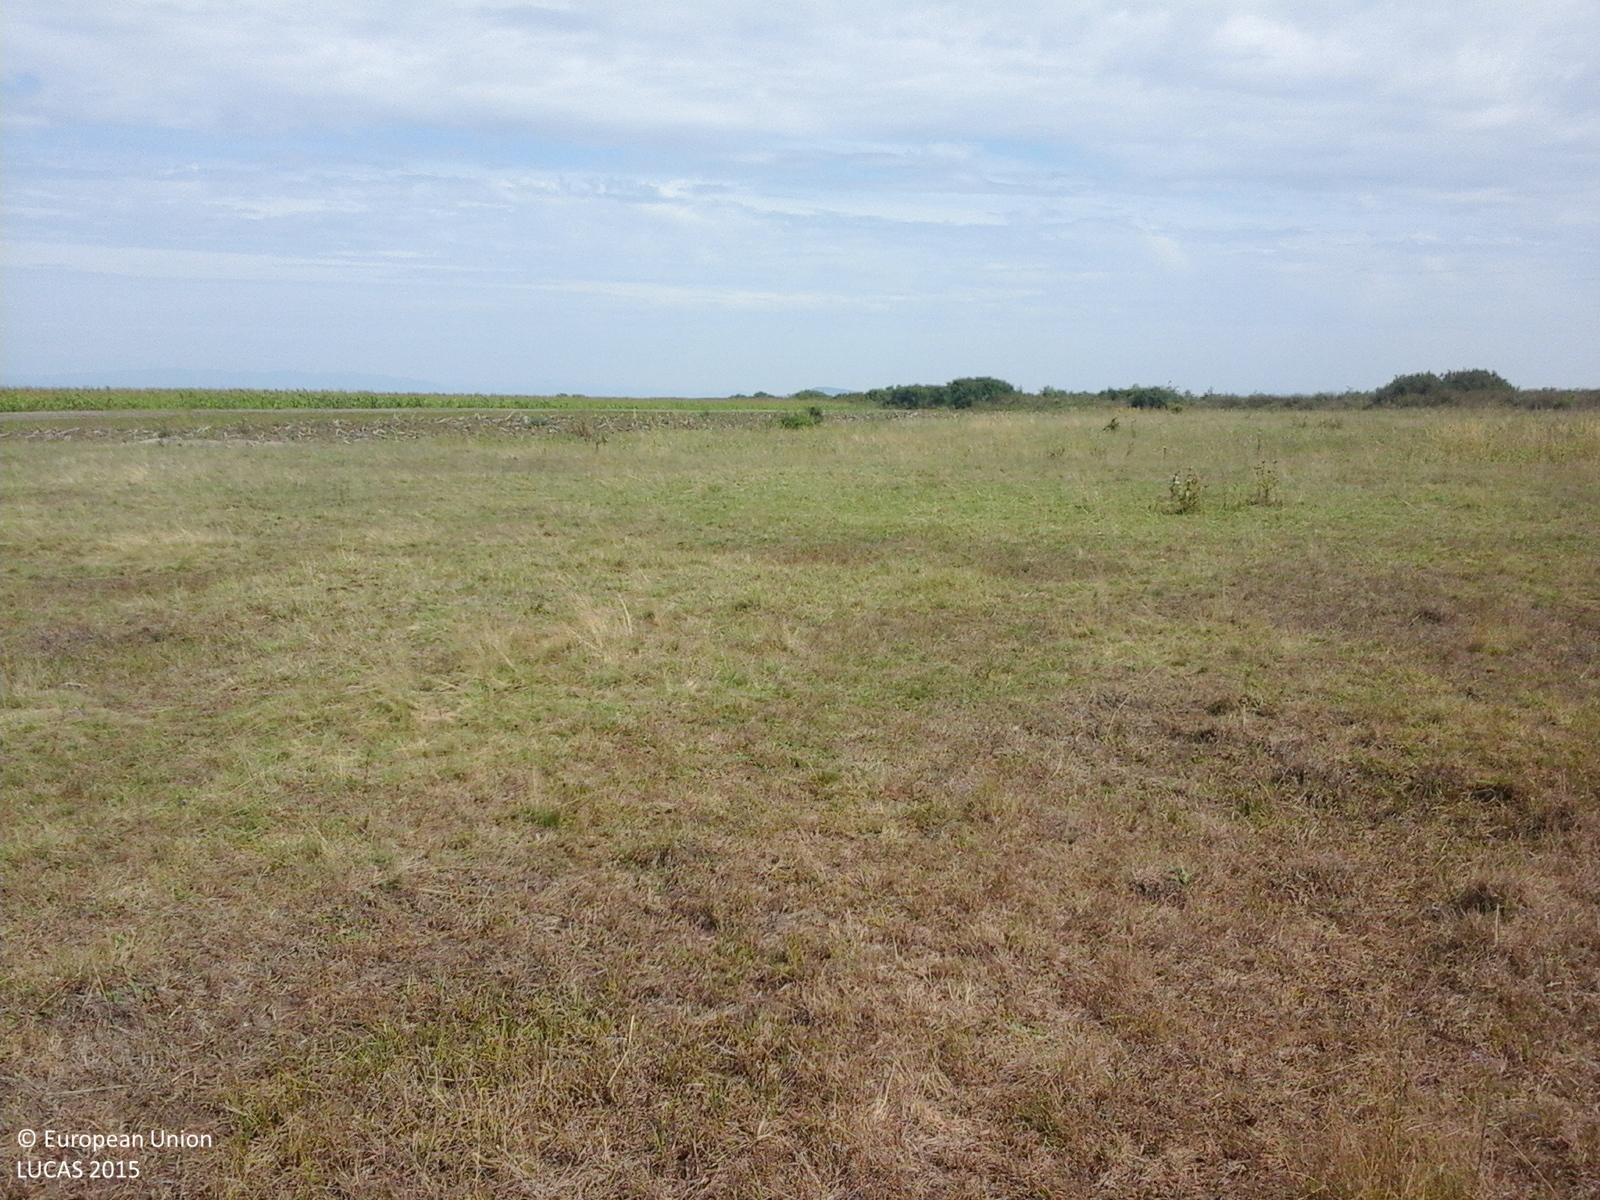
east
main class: Grassland
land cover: Grassland without tree/shrub cover
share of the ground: > 75 %
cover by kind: herbaceous plants 100 %
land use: Agriculture (excluding fallow land and kitchen gardens)
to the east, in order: Grassland without tree/shrub cover; Other bare soil; Spontaneously vegetated surfaces; Grassland without tree/shrub cover; Maize
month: August
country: RO
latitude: 46.4169
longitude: 21.5259
